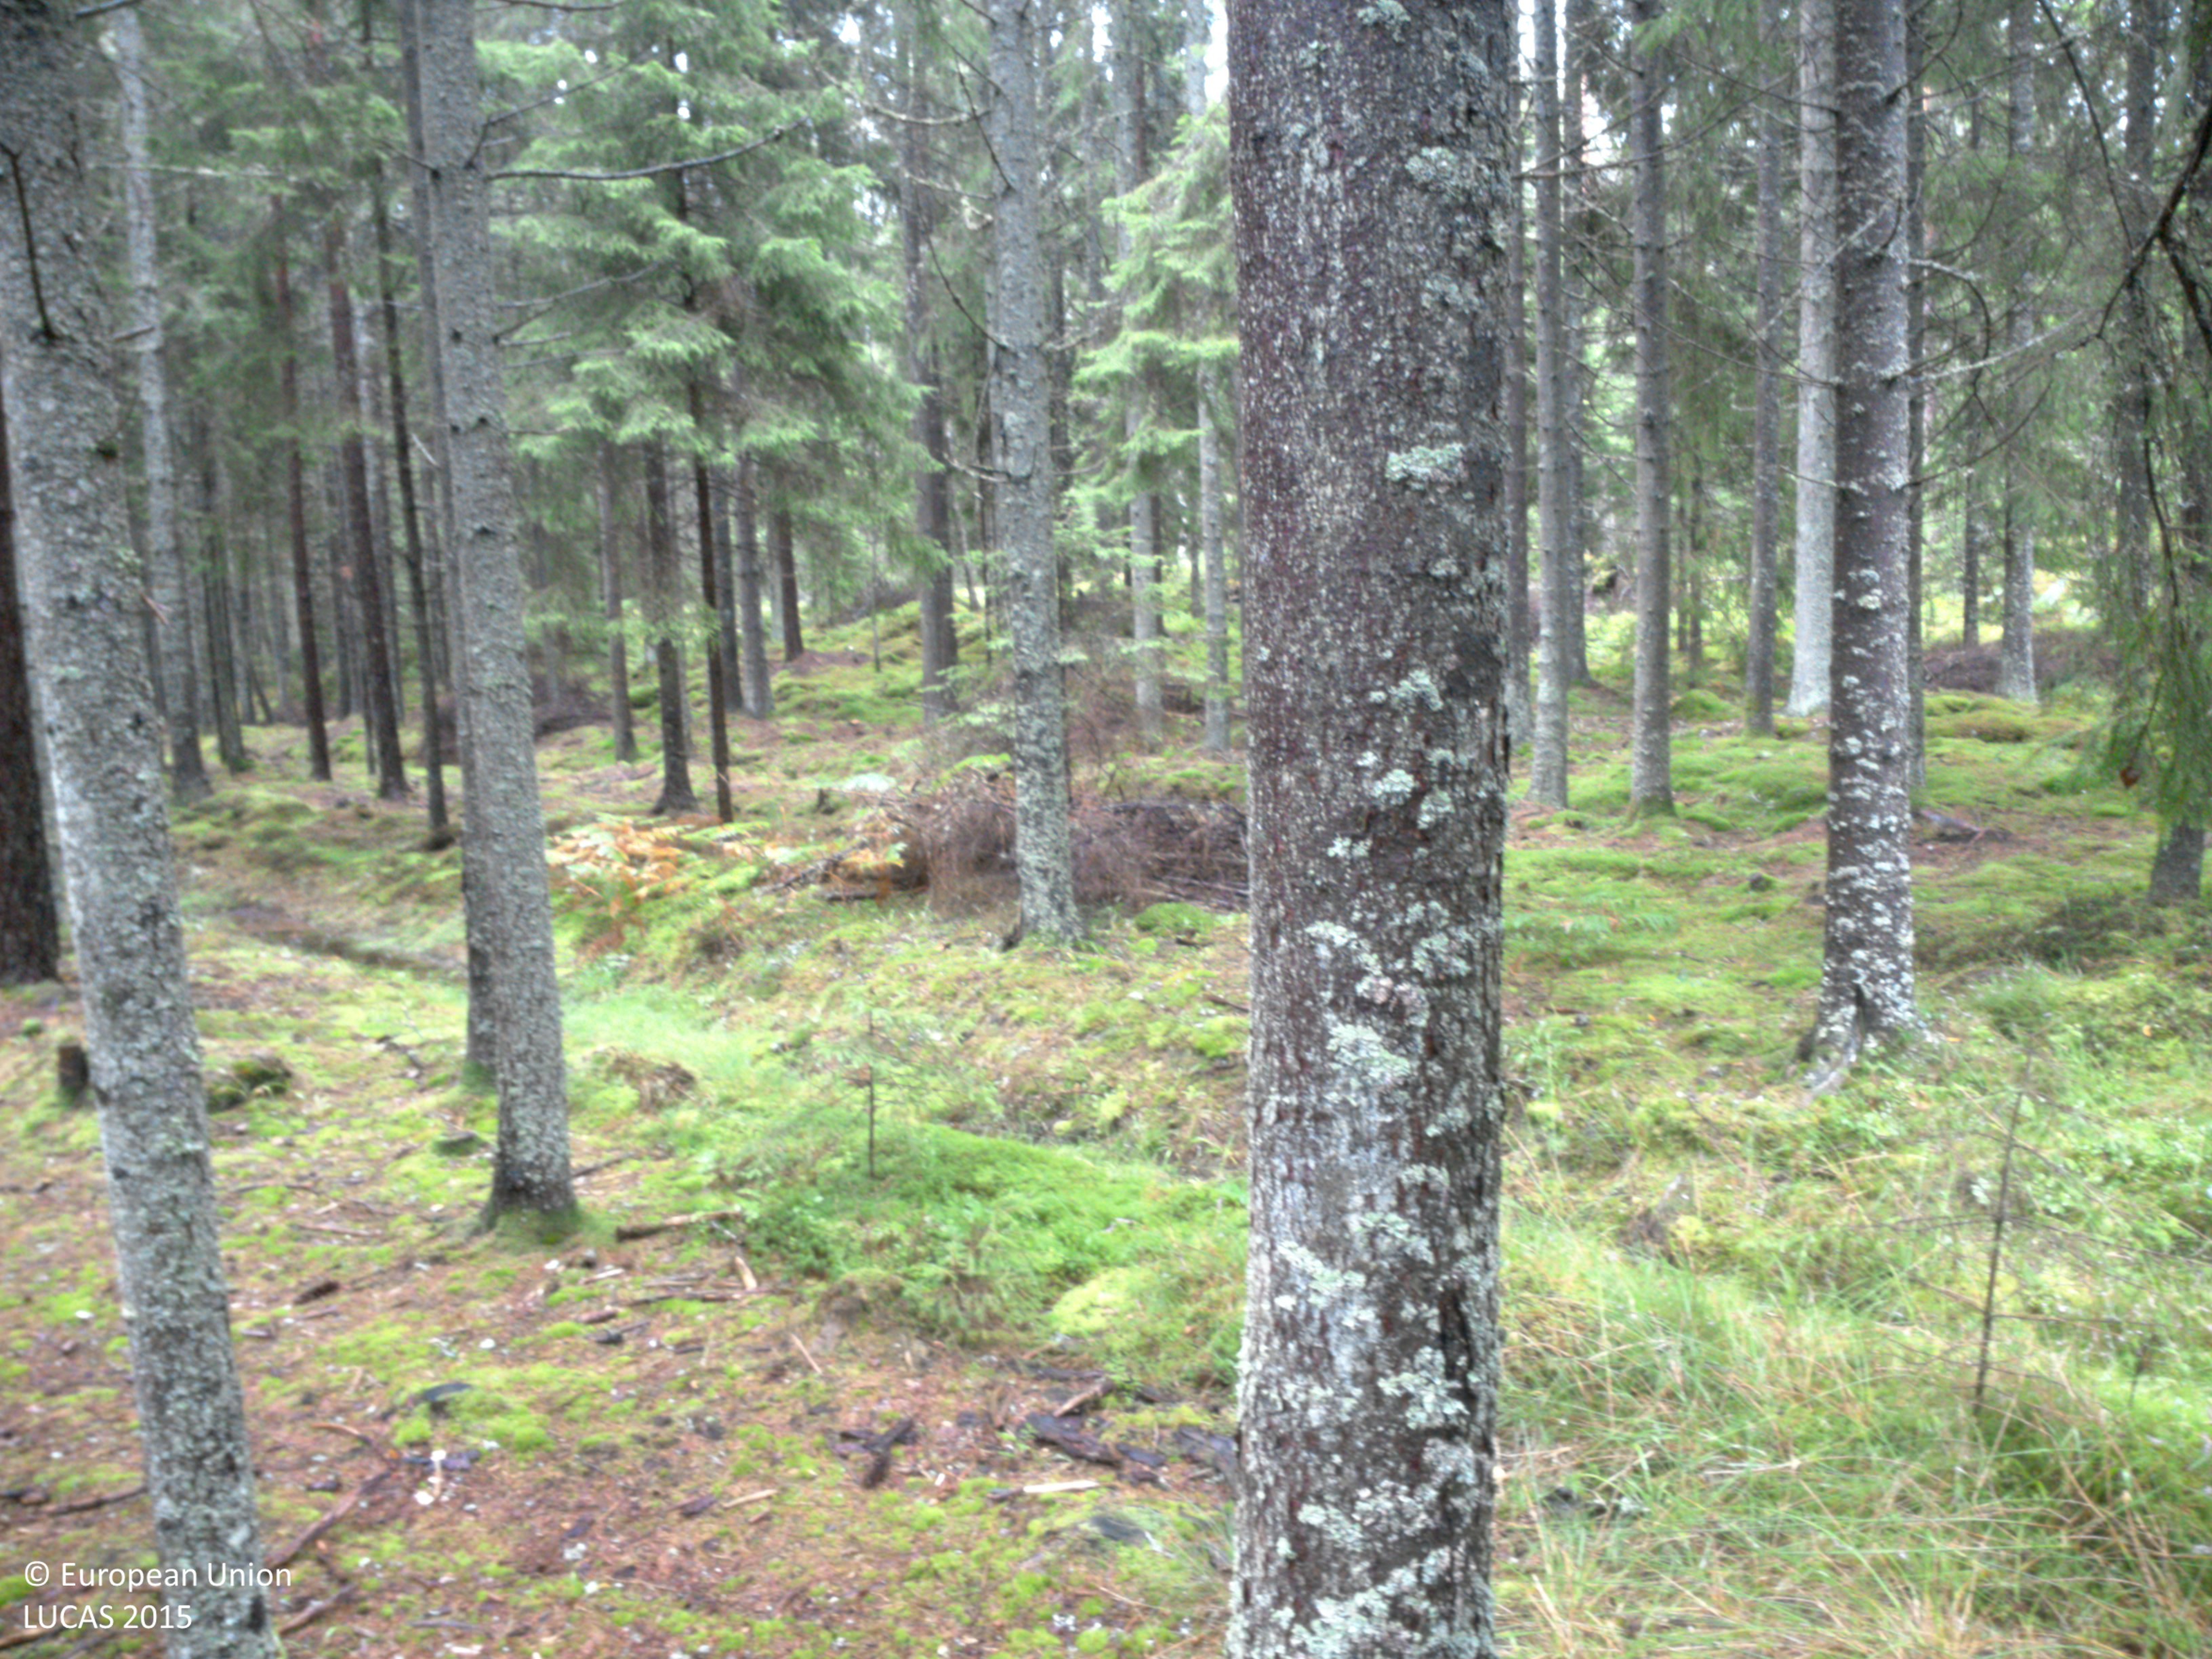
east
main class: Woodland
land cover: Spruce dominated coniferous woodland
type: boreal forest
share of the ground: 50 - 75 %
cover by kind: coniferous forest trees 70 %, lichens and mosses 30 %
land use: Forestry
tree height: > 5 m
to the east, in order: Spruce dominated coniferous woodland; Ditches and canals; Spruce dominated coniferous woodland; Spruce dominated mixed woodland; Spruce dominated coniferous woodland; Ditches and canals; Spruce dominated coniferous woodland; Ditches and canals; Spruce dominated coniferous woodland; Ditches and canals; Spruce dominated coniferous woodland; Spruce dominated mixed woodland; Spruce dominated coniferous woodland; Pine dominated mixed woodland
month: August
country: SE
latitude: 58.0921
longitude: 12.2858
